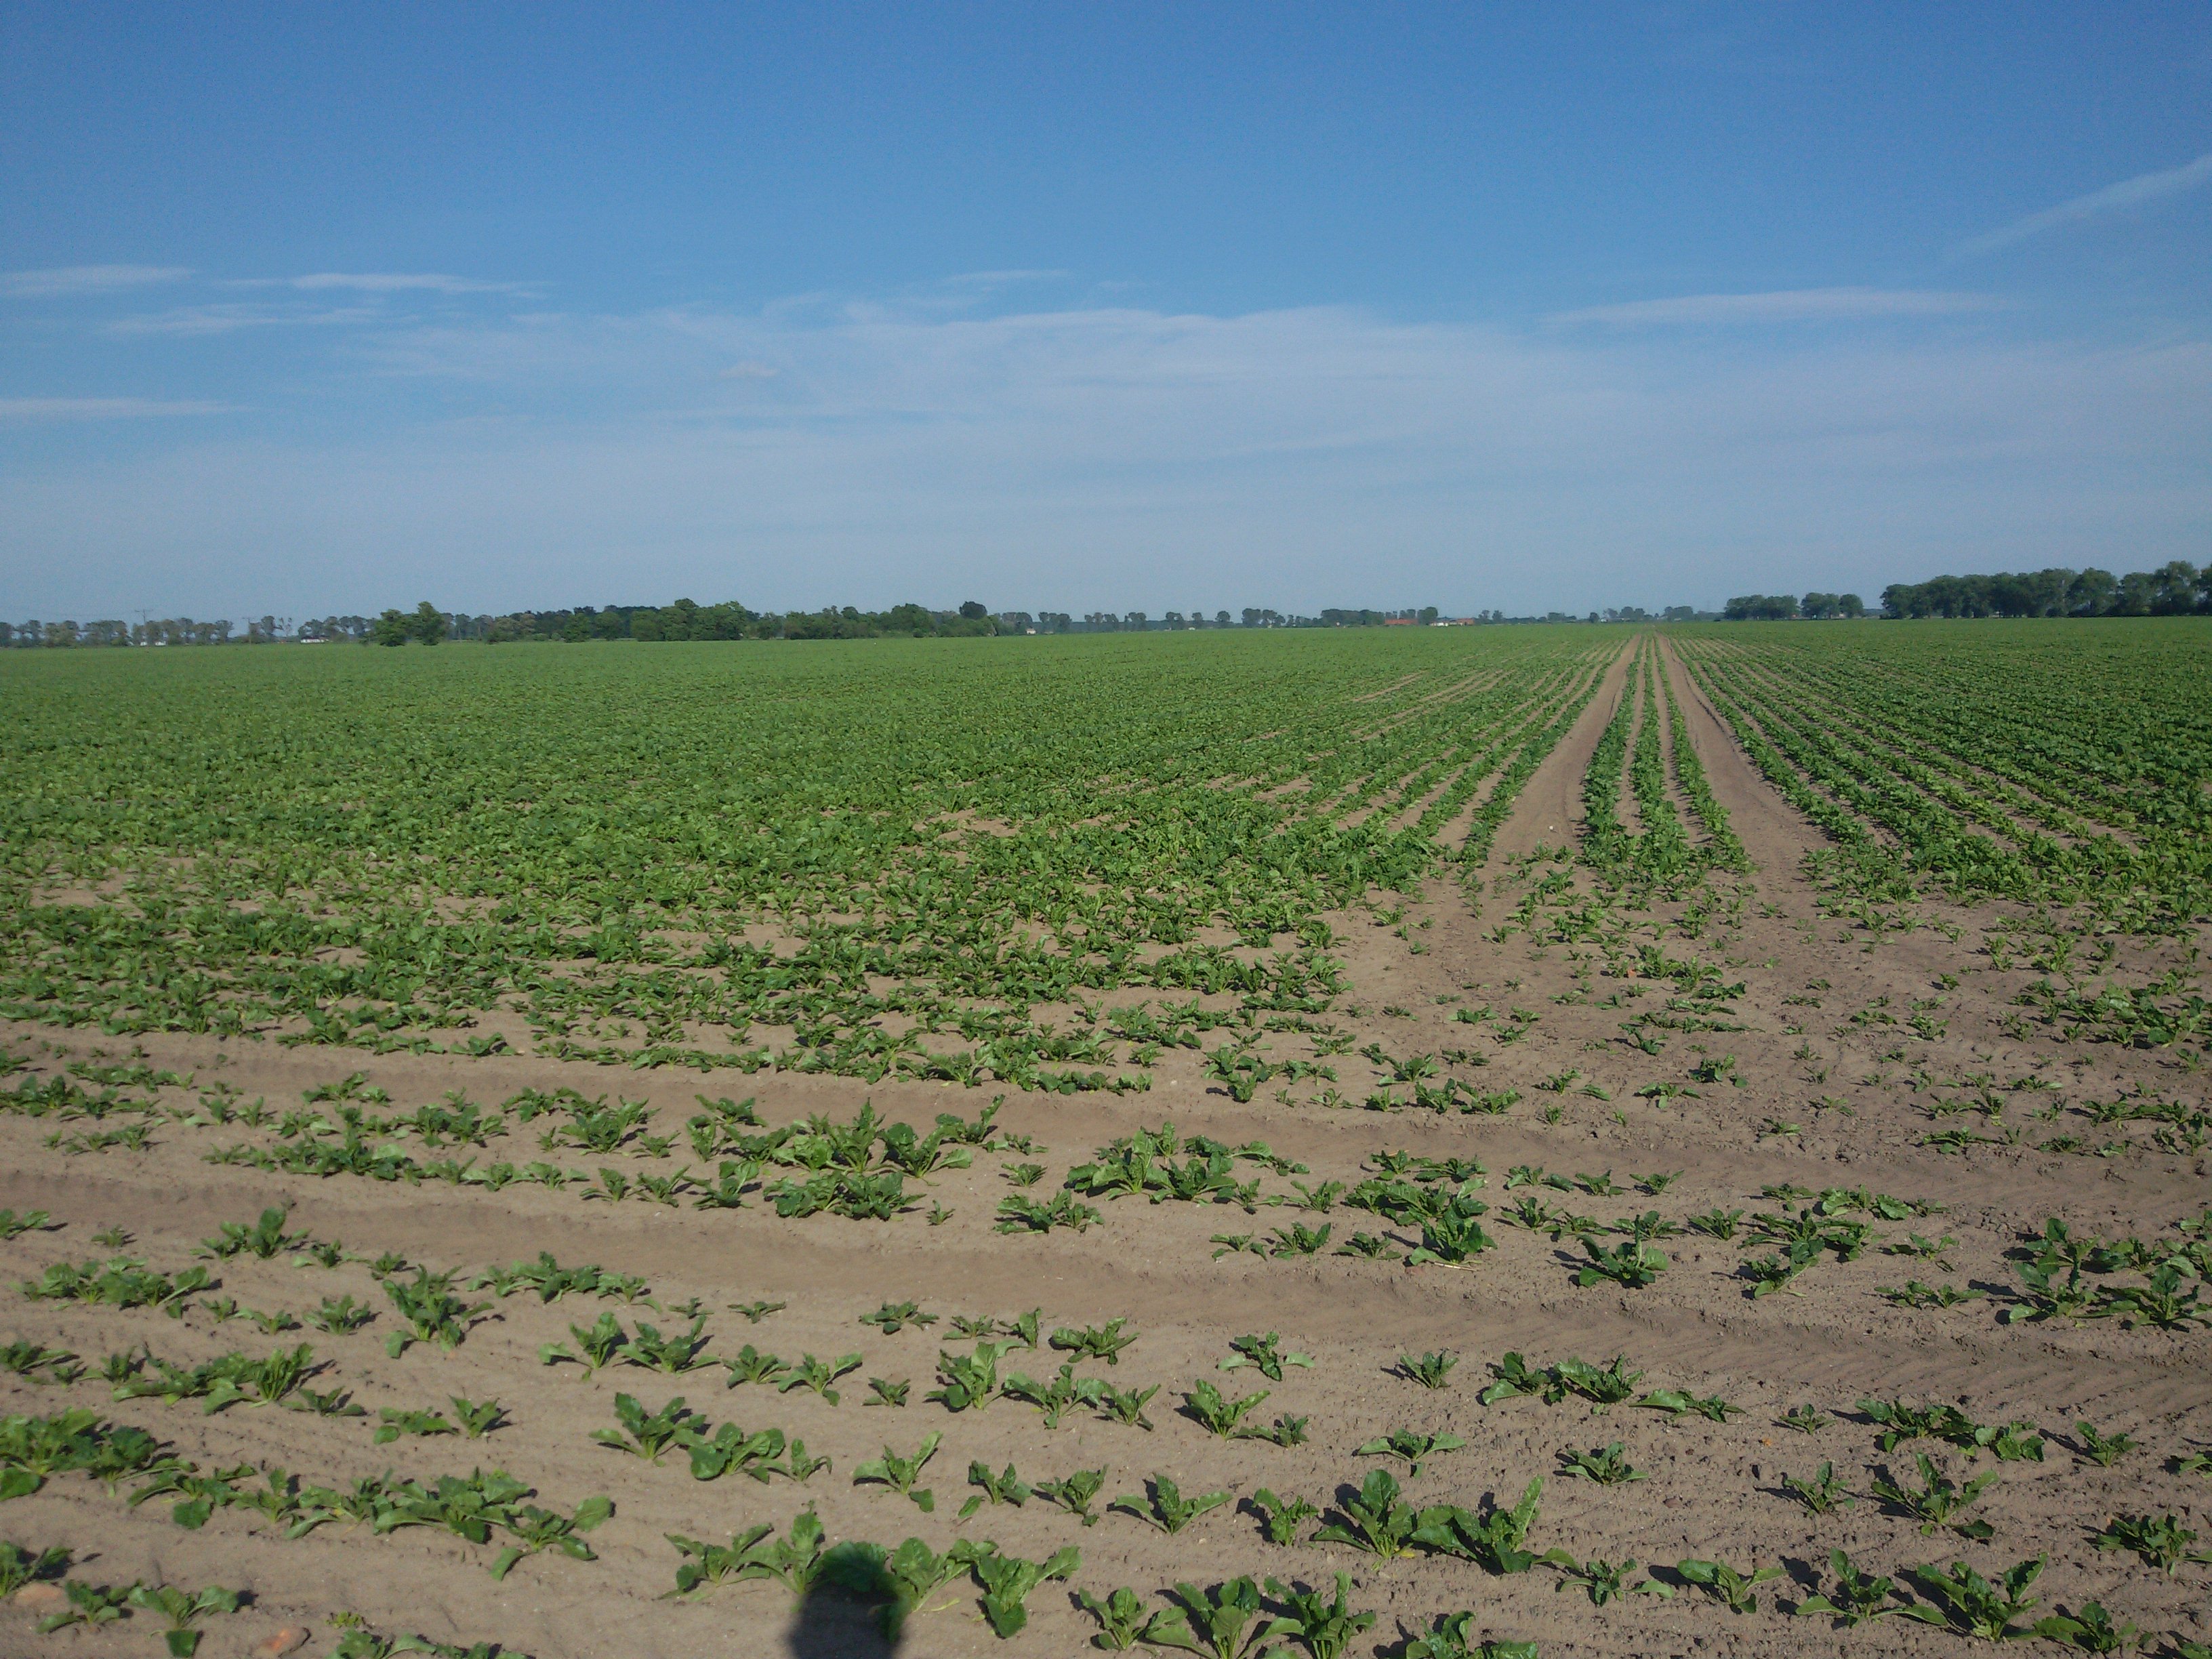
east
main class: Cropland
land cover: Sugar beet
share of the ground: 25 - 50 %
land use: Agriculture (excluding fallow land and kitchen gardens)
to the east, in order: Sugar beet
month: June
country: PL
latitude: 52.3239
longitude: 17.1560
